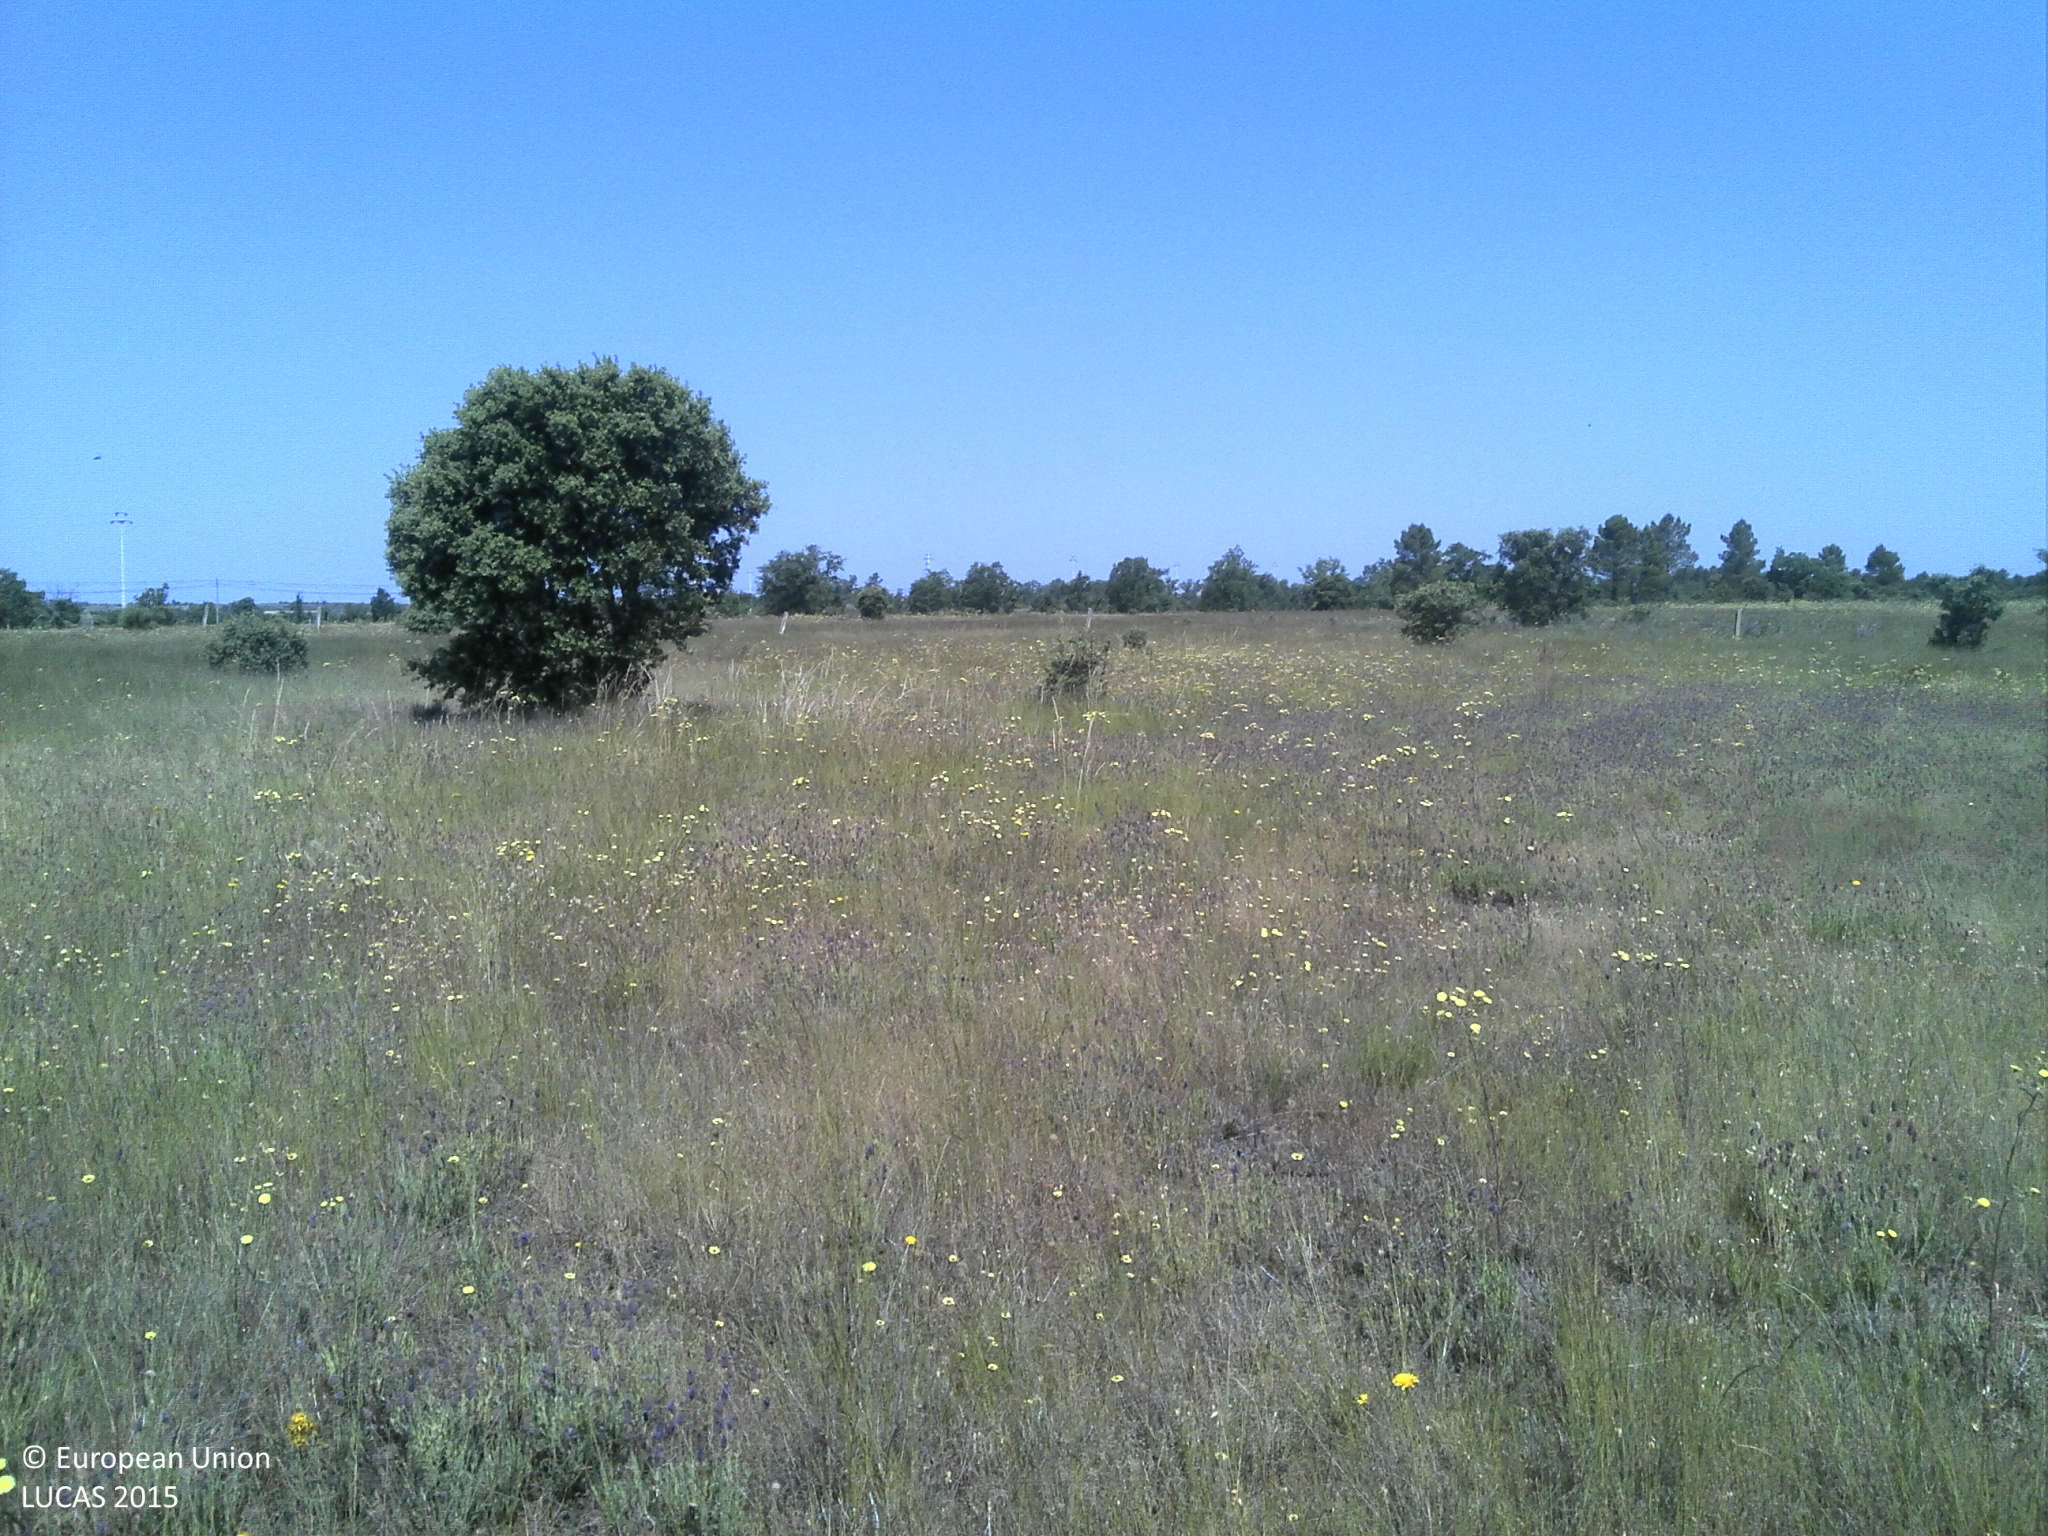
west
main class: Grassland
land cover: Grassland with sparse tree/shrub cover
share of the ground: 50 - 75 %
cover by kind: herbaceous plants 60 %, unconsolidated bare surface 30 %, broadleaved forest trees 5 %
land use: Agriculture (excluding fallow land and kitchen gardens)
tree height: > 5 m
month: June
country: PT
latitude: 40.5310
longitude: -6.8474
